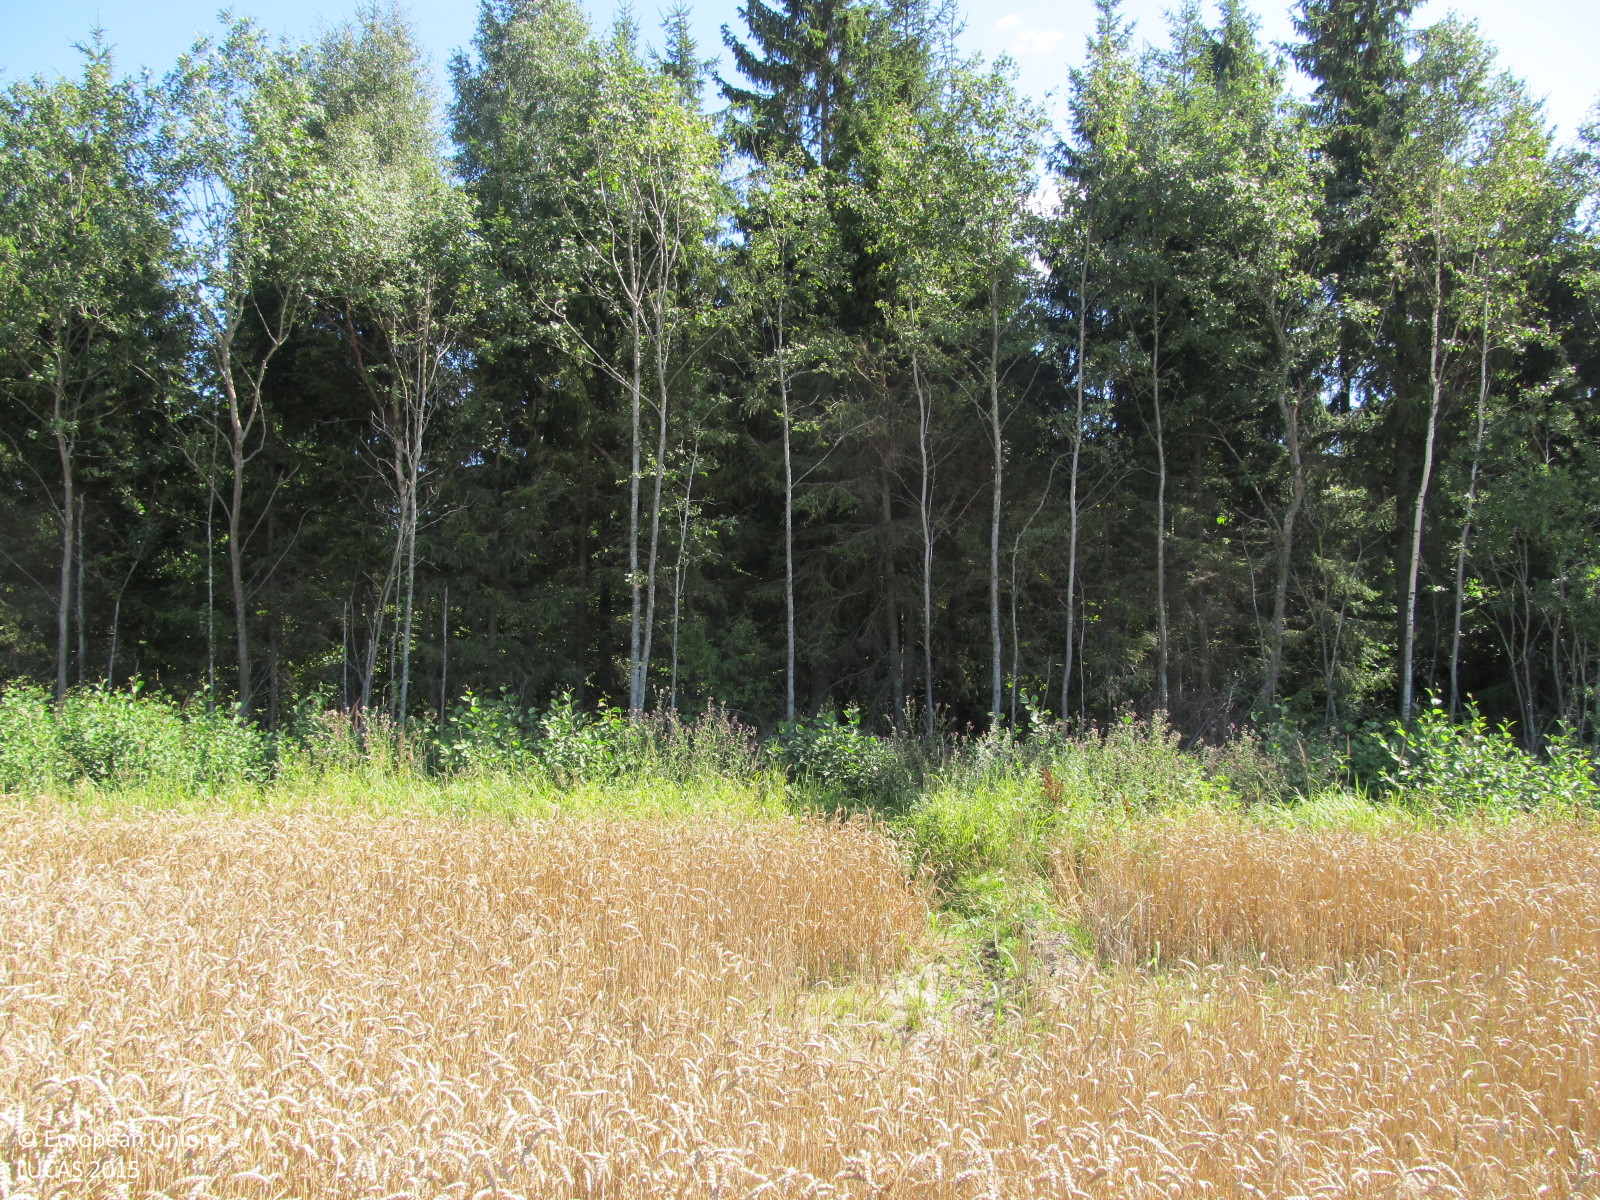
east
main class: Cropland
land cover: Common wheat
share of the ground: > 75 %
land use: Agriculture (excluding fallow land and kitchen gardens)
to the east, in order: Common wheat; Tracks; Common wheat; Shruby margins; Abandoned hedges; Ditches and canals; Spruce dominated mixed woodland; Tracks; Broadleaved woodland; Spruce dominated mixed woodland
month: August
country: LT
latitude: 56.0829
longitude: 22.8724
